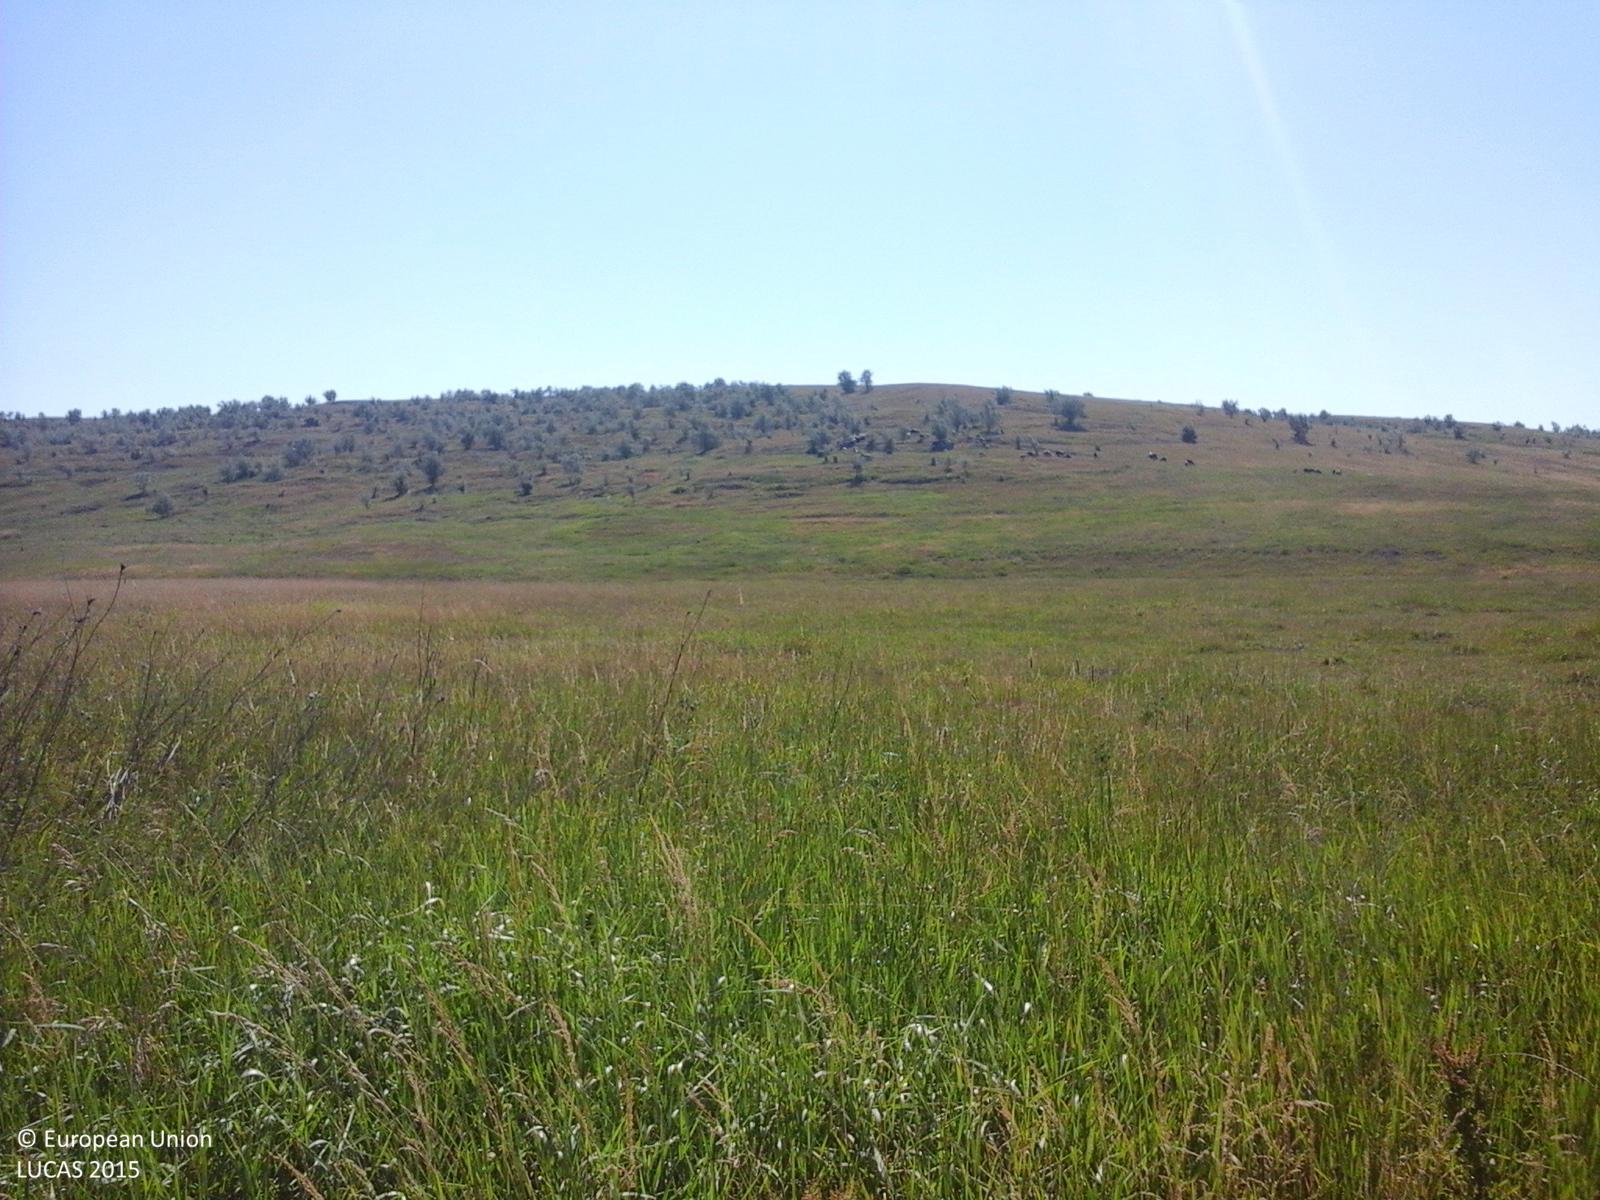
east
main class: Grassland
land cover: Grassland without tree/shrub cover
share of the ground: > 75 %
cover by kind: herbaceous plants 100 %
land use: Agriculture (excluding fallow land and kitchen gardens)
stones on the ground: < 10 %
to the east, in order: Grassland without tree/shrub cover; Tracks; Shrubland with sparse tree cover
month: June
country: RO
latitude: 47.7820
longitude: 26.8232
